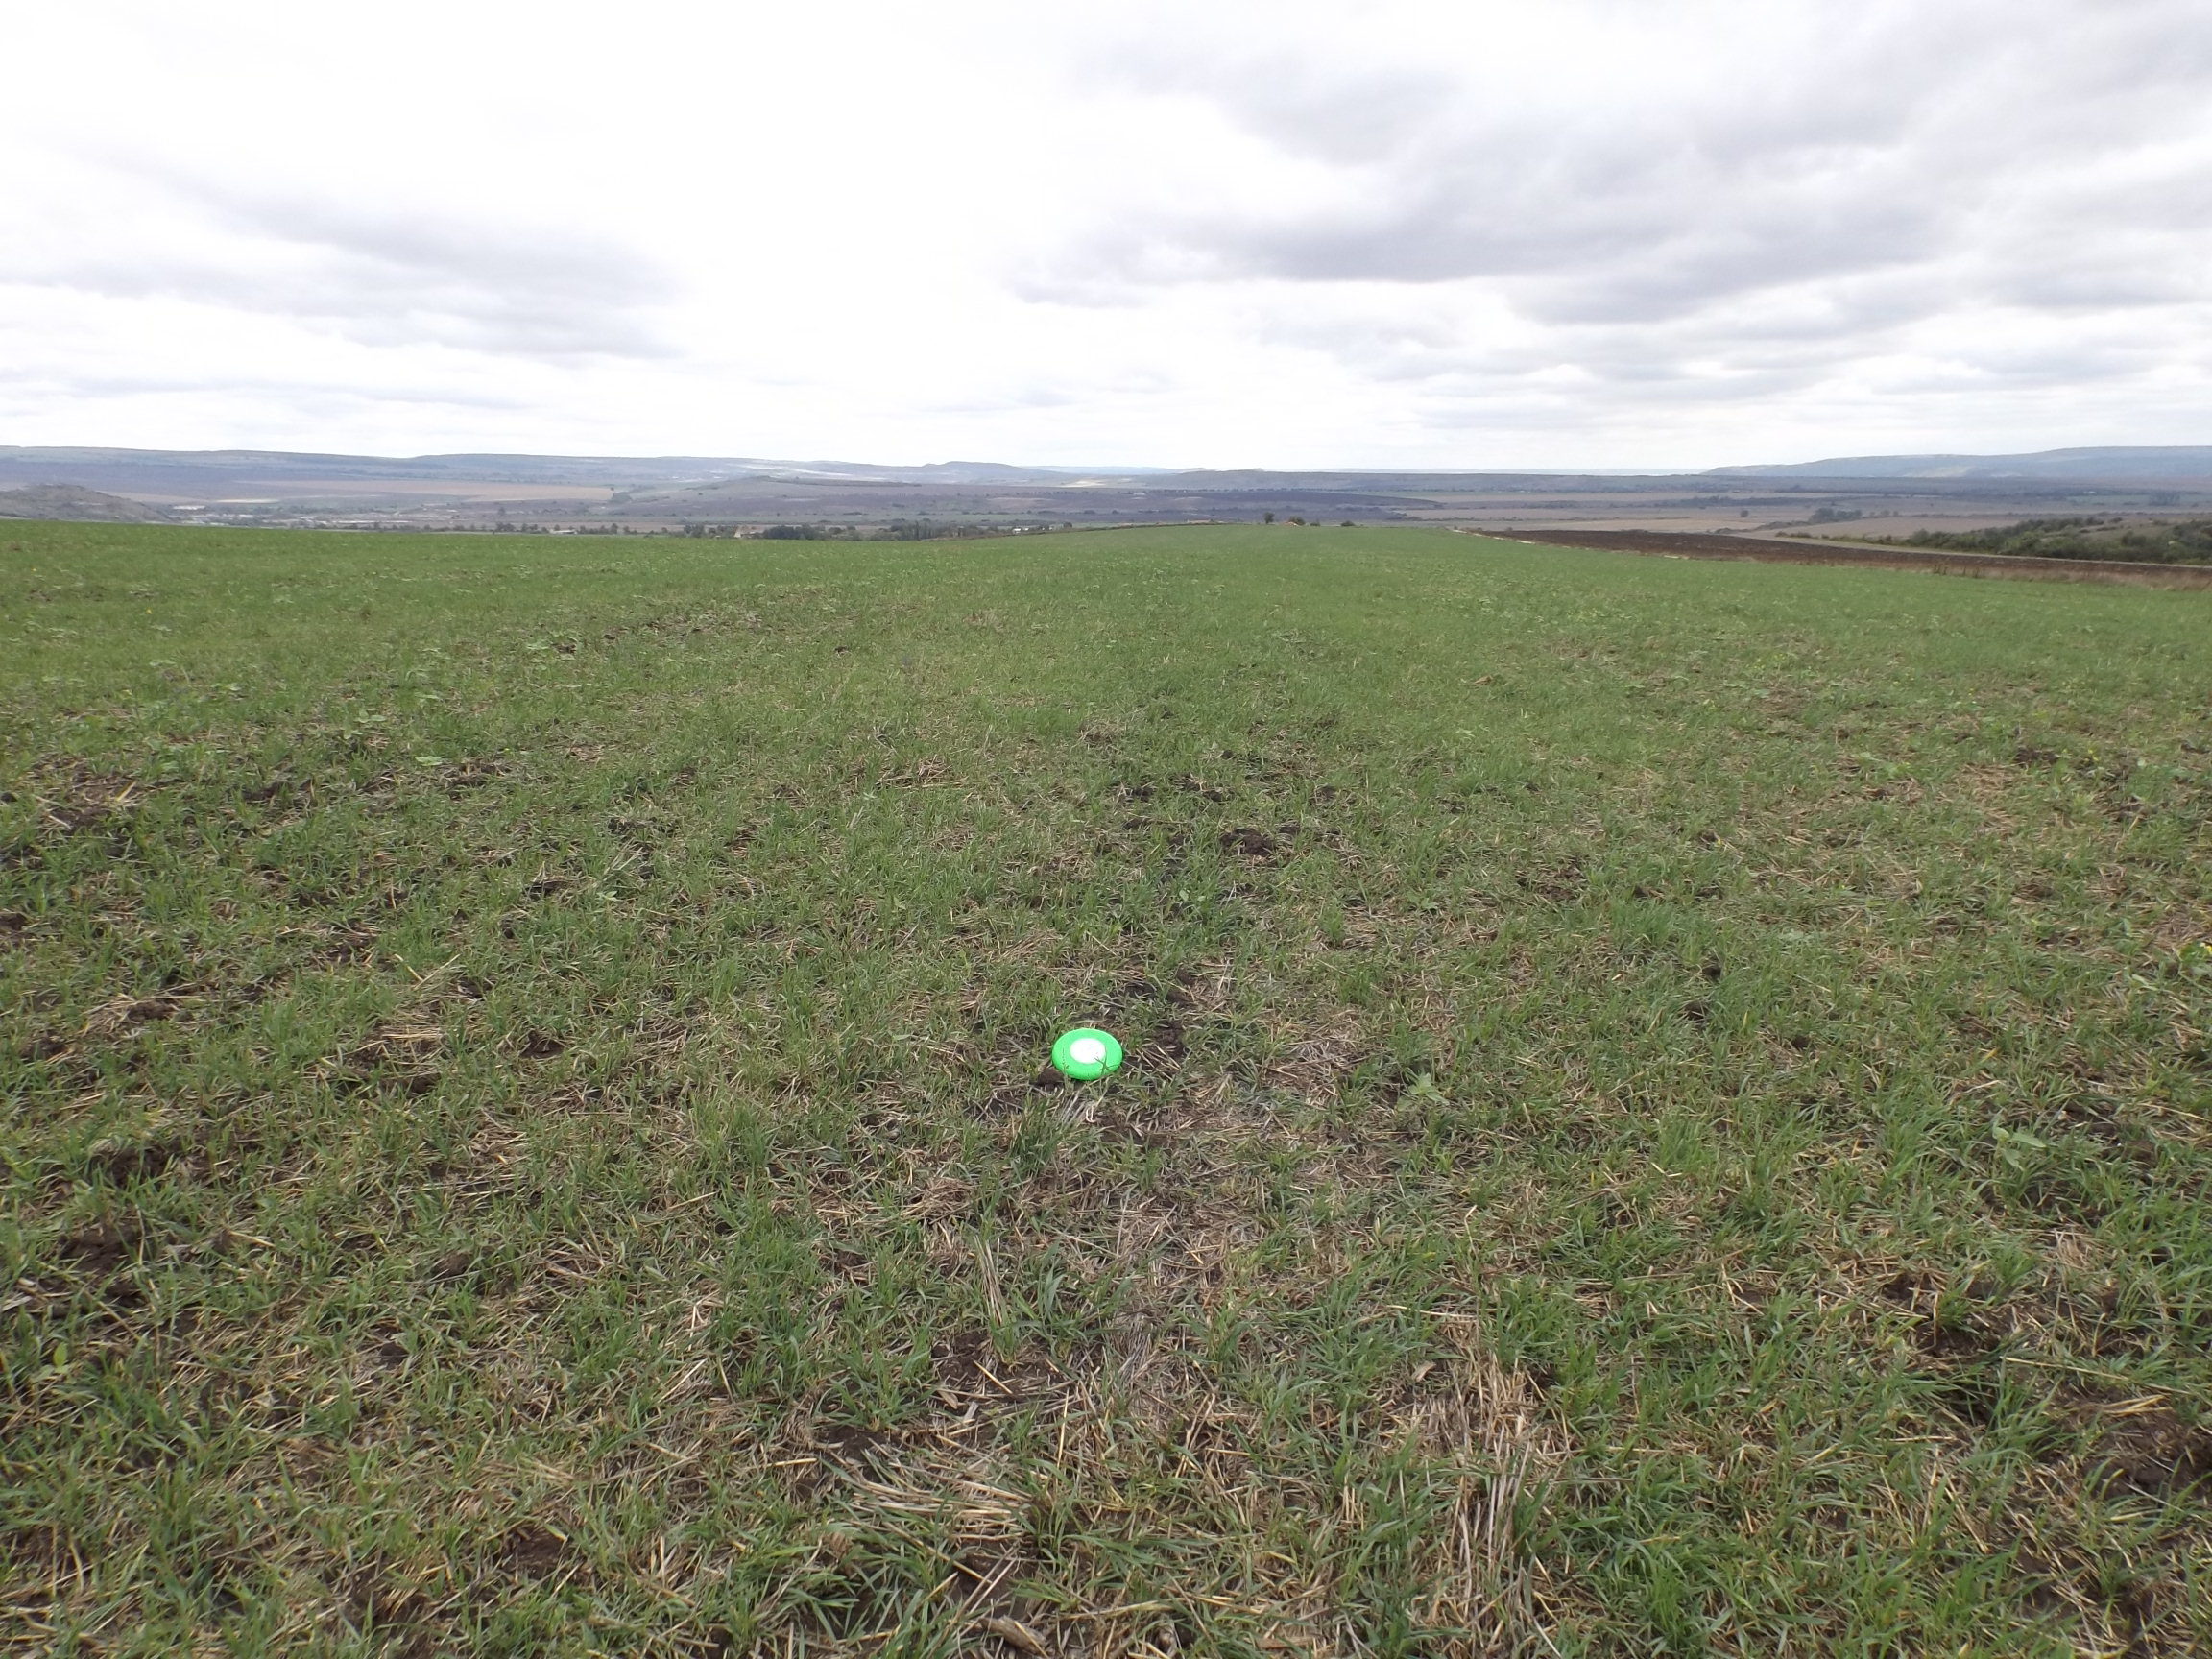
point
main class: Cropland
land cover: Common wheat
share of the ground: < 10 %
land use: Agriculture (excluding fallow land and kitchen gardens)
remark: Harvested field
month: September
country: BG
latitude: 43.0957
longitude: 27.4600
